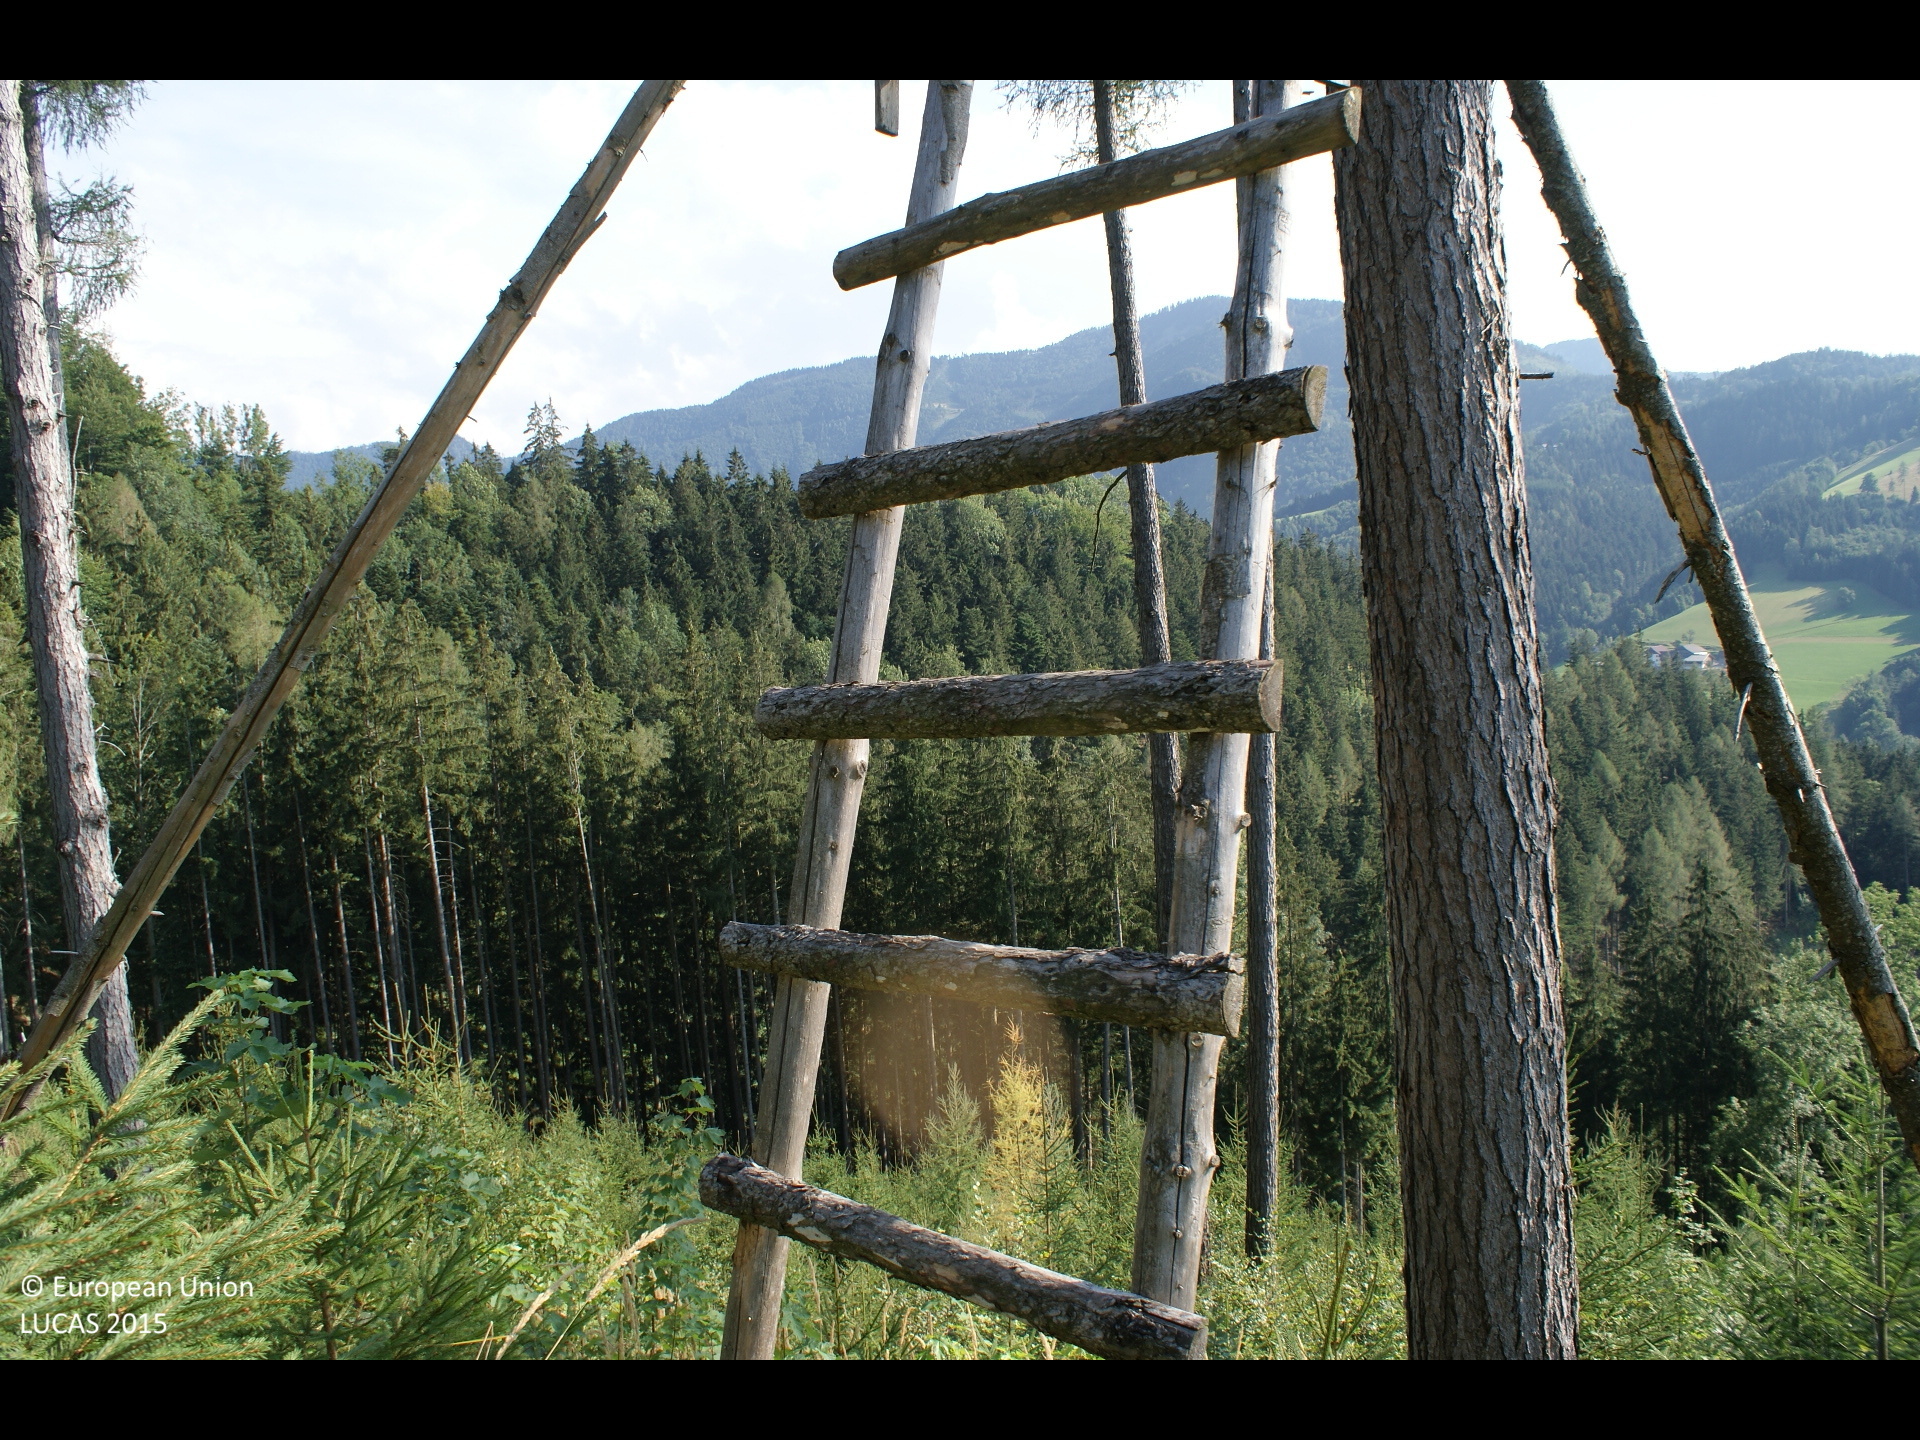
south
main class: Woodland
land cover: Spruce dominated mixed woodland
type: alpine coniferous forest
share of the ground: > 75 %
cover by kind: coniferous forest trees 65 %, broadleaved forest trees 25 %, shrubs 10 %
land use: Forestry
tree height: < 5 m
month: August
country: AT
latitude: 47.9168
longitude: 14.0003
